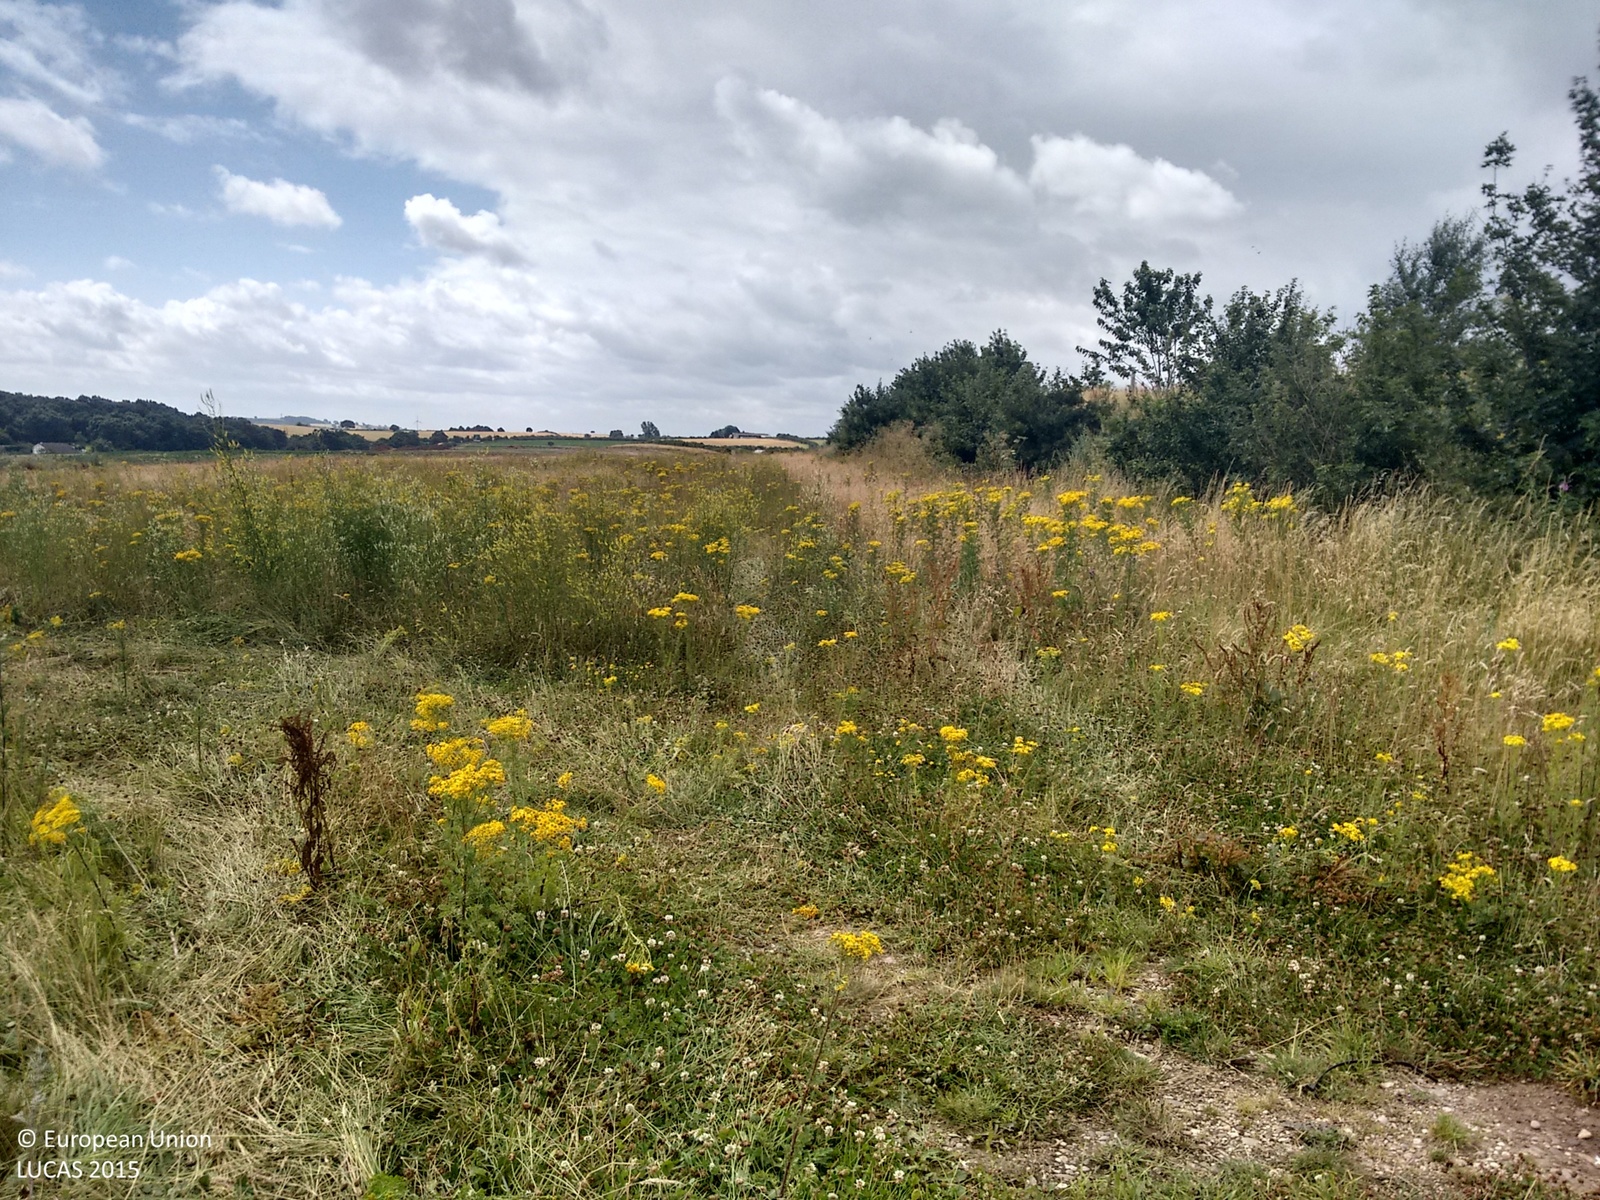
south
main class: Grassland
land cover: Spontaneously vegetated surfaces
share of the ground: > 75 %
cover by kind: herbaceous plants 100 %
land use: Agriculture (excluding fallow land and kitchen gardens)
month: July
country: GB
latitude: 53.1296
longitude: -1.0593
